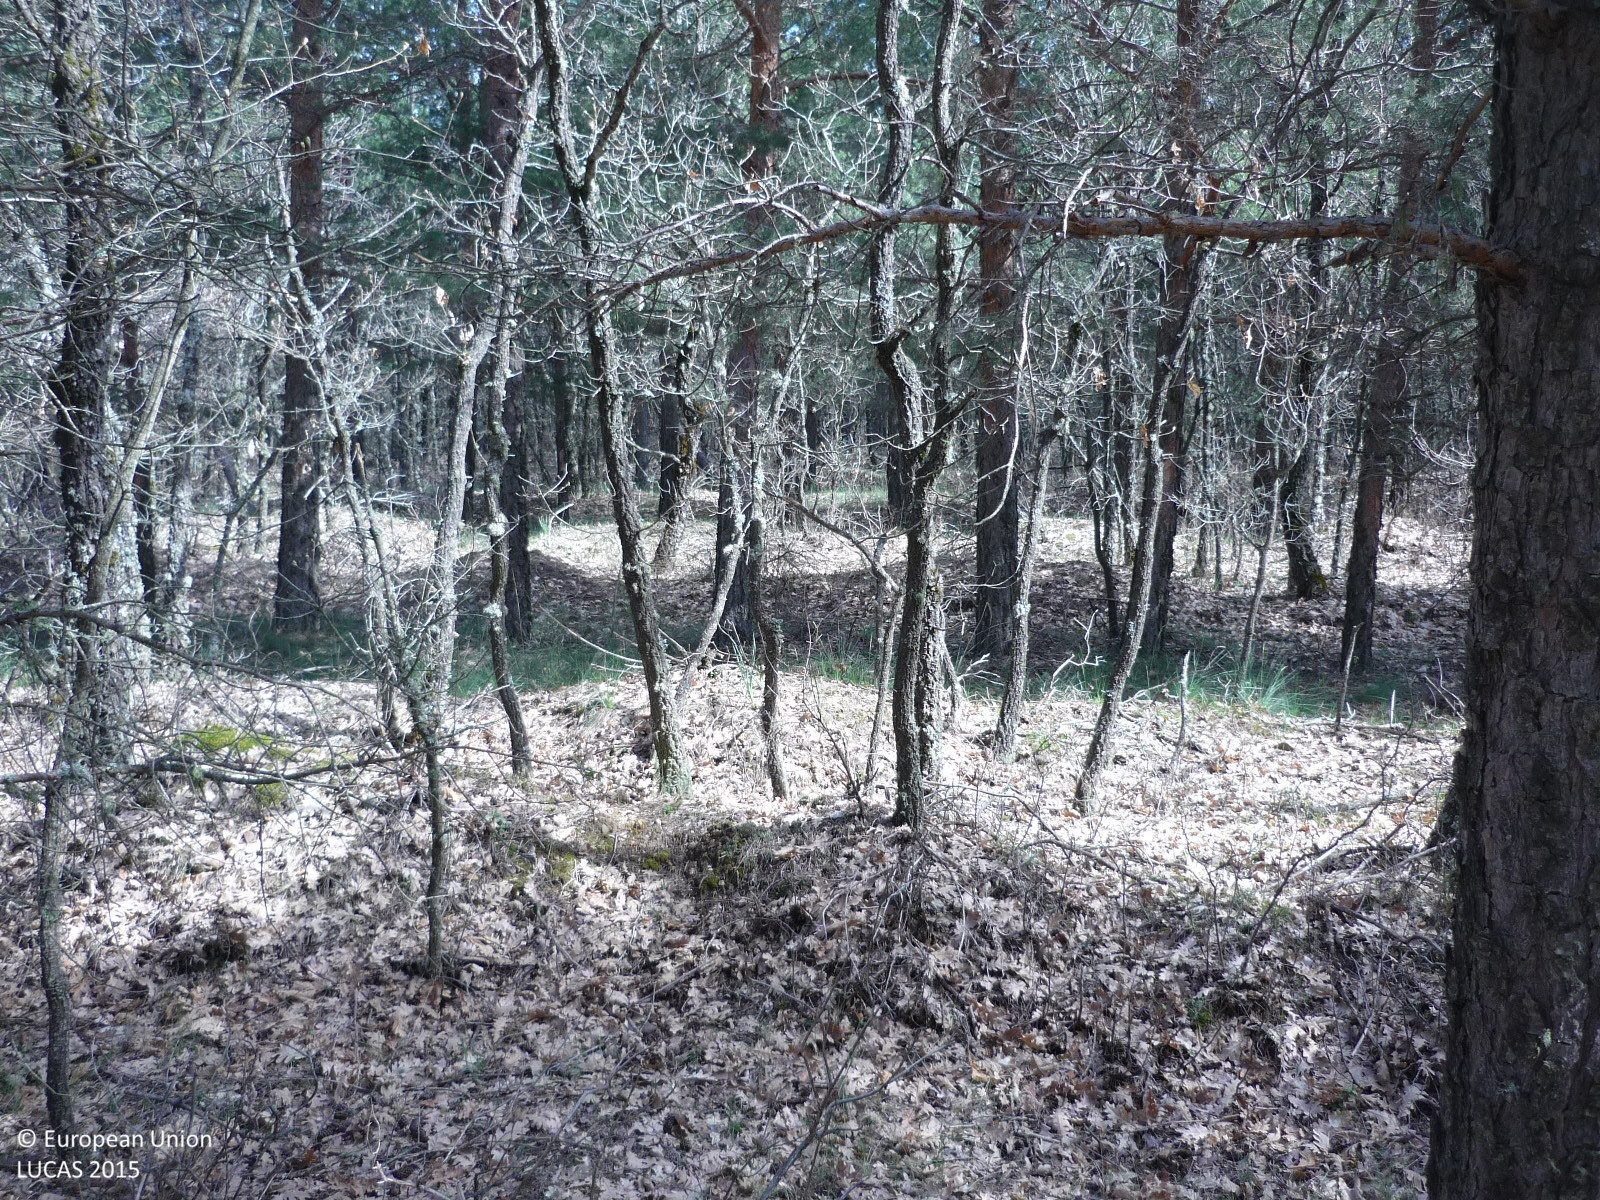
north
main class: Woodland
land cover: Pine dominated mixed woodland
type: coniferous forest of the mediterranean region
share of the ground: > 75 %
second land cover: Grassland without tree/shrub cover
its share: 10 - 25 %
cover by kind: coniferous forest trees 50 %, broadleaved forest trees 45 %, herbaceous plants 5 %
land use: Forestry
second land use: Agriculture (excluding fallow land and kitchen gardens)
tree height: > 5 m
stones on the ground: 10 - 25 %
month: April
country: ES
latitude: 41.2670
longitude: -3.5223
